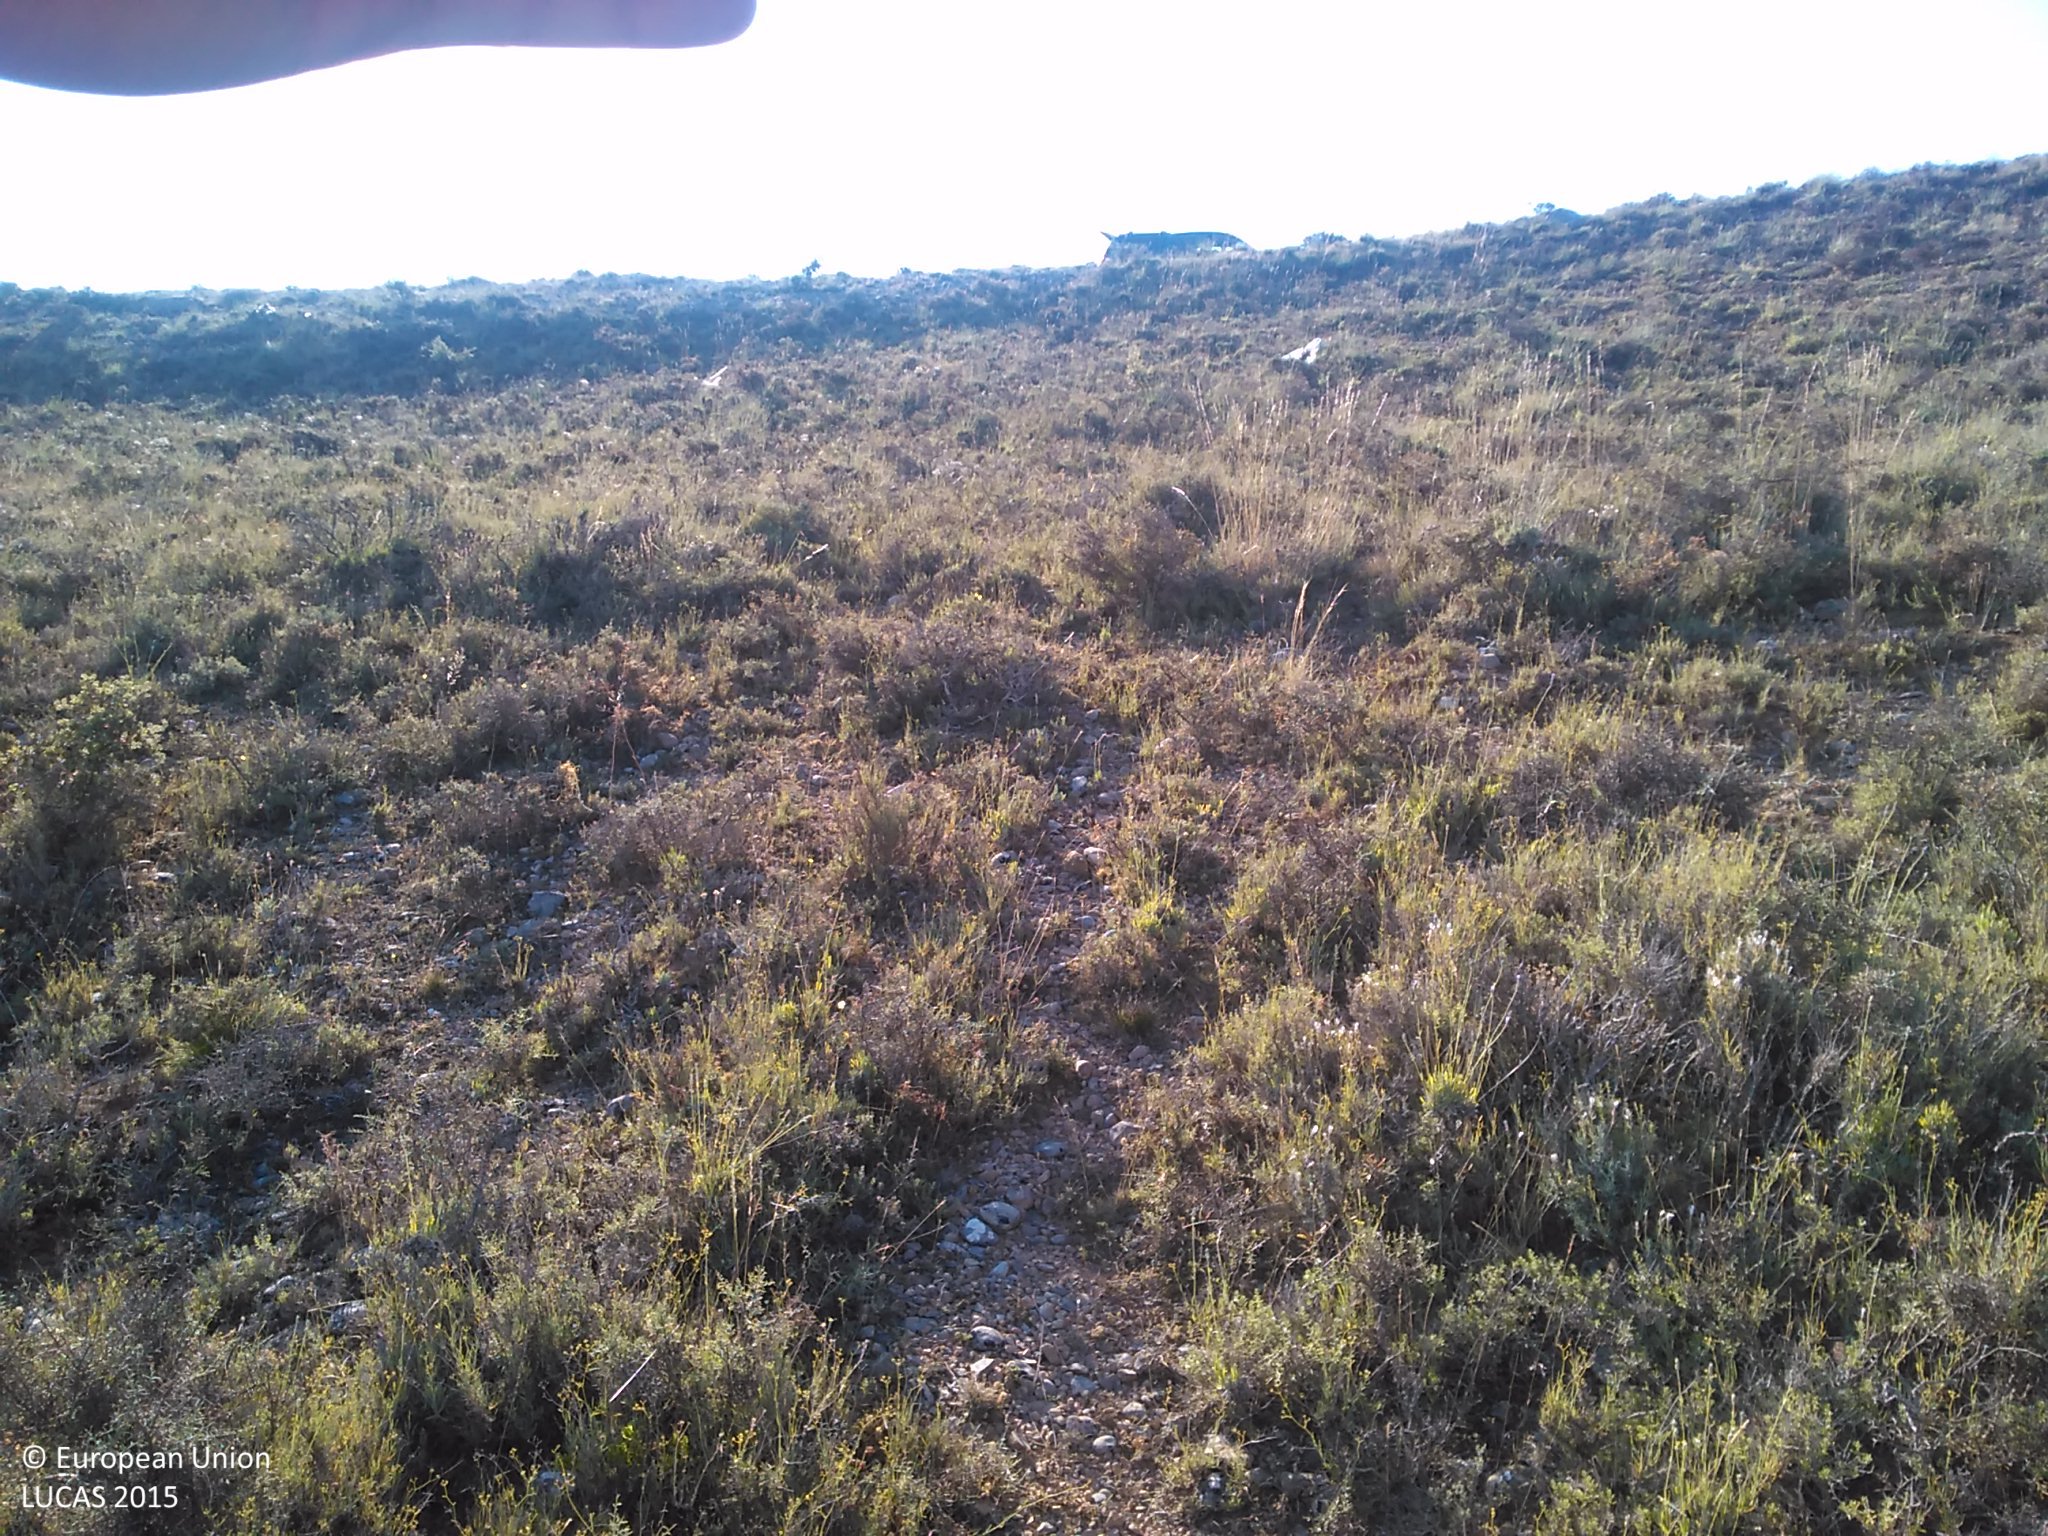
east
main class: Shrubland
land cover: Shrubland without tree cover
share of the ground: 50 - 75 %
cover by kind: shrubs 70 %, unconsolidated bare surface 30 %
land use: Semi-natural and natural areas not in use
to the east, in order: Shrubland without tree cover; Tracks; Barley; Other bare soil; Shrubland without tree cover; Other bare soil
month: July
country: ES
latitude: 41.4950
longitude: -2.1903
